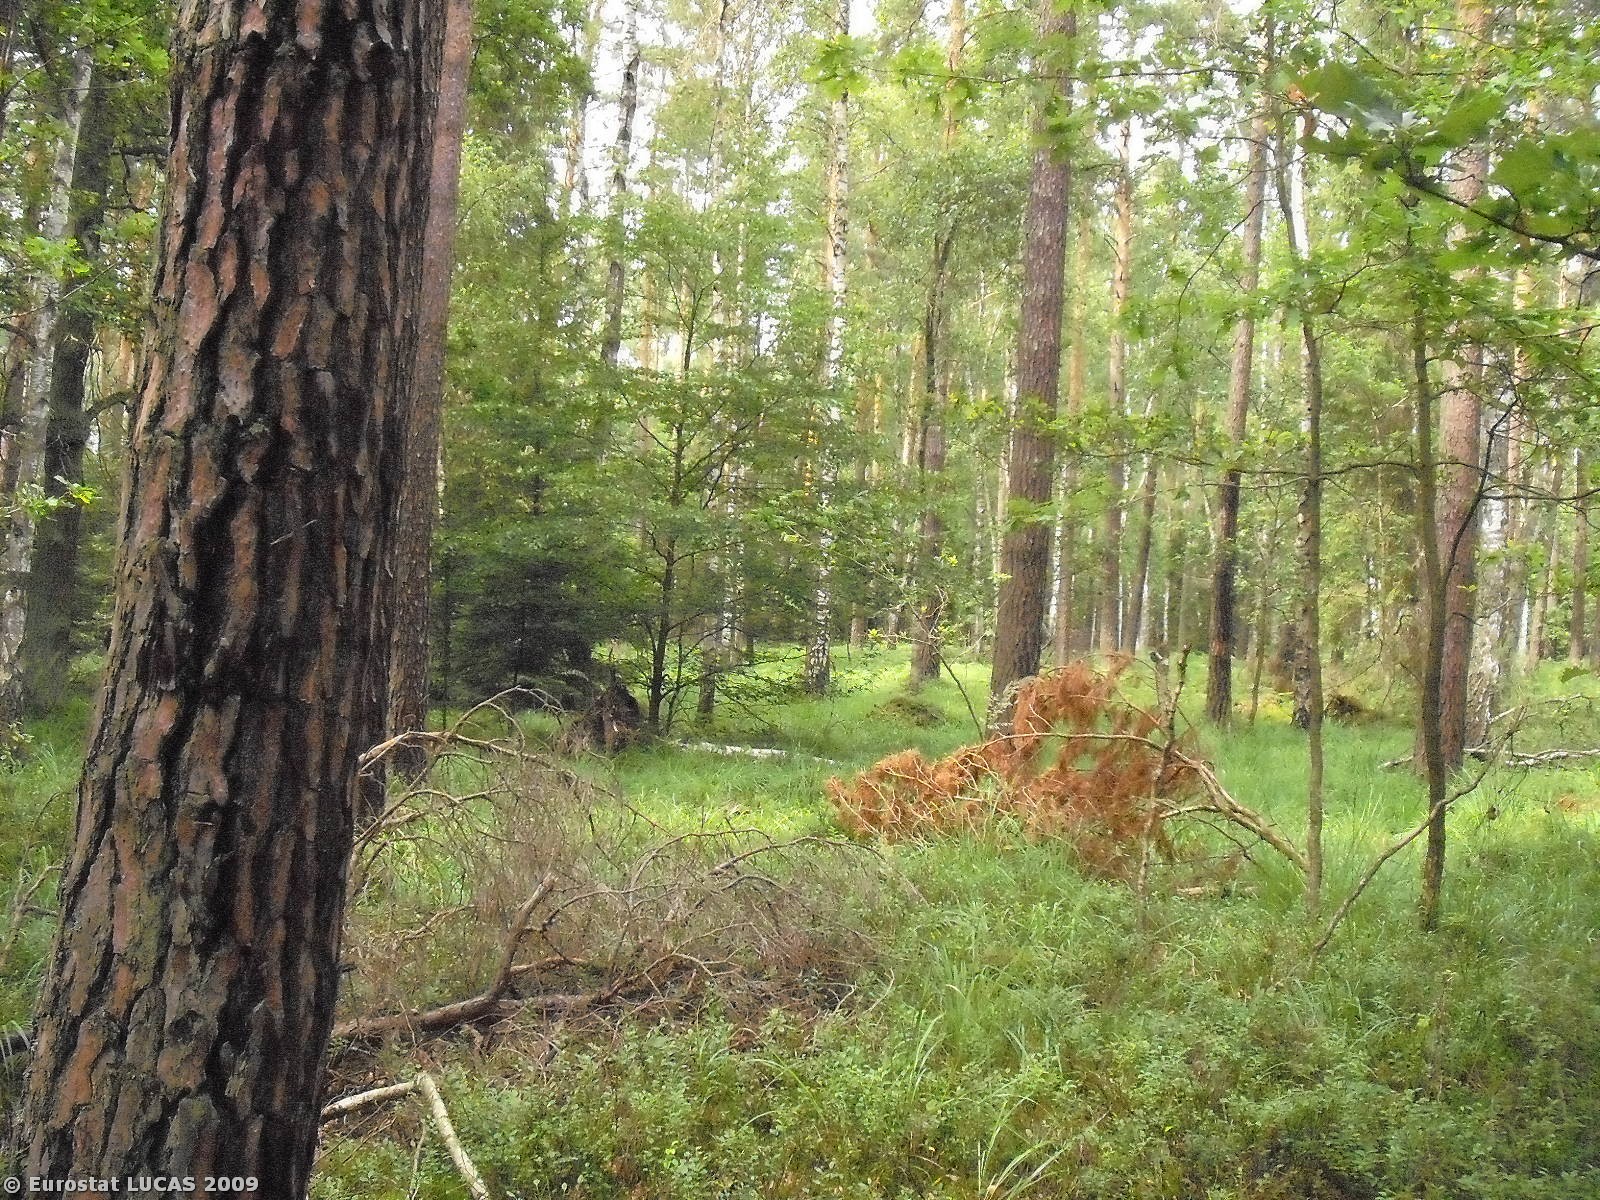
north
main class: Woodland
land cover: Mixed woodland
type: mesophytic deciduous forest
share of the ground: > 75 %
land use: Forestry
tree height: > 5 m
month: July
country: PL
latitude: 51.0368
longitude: 20.9246
